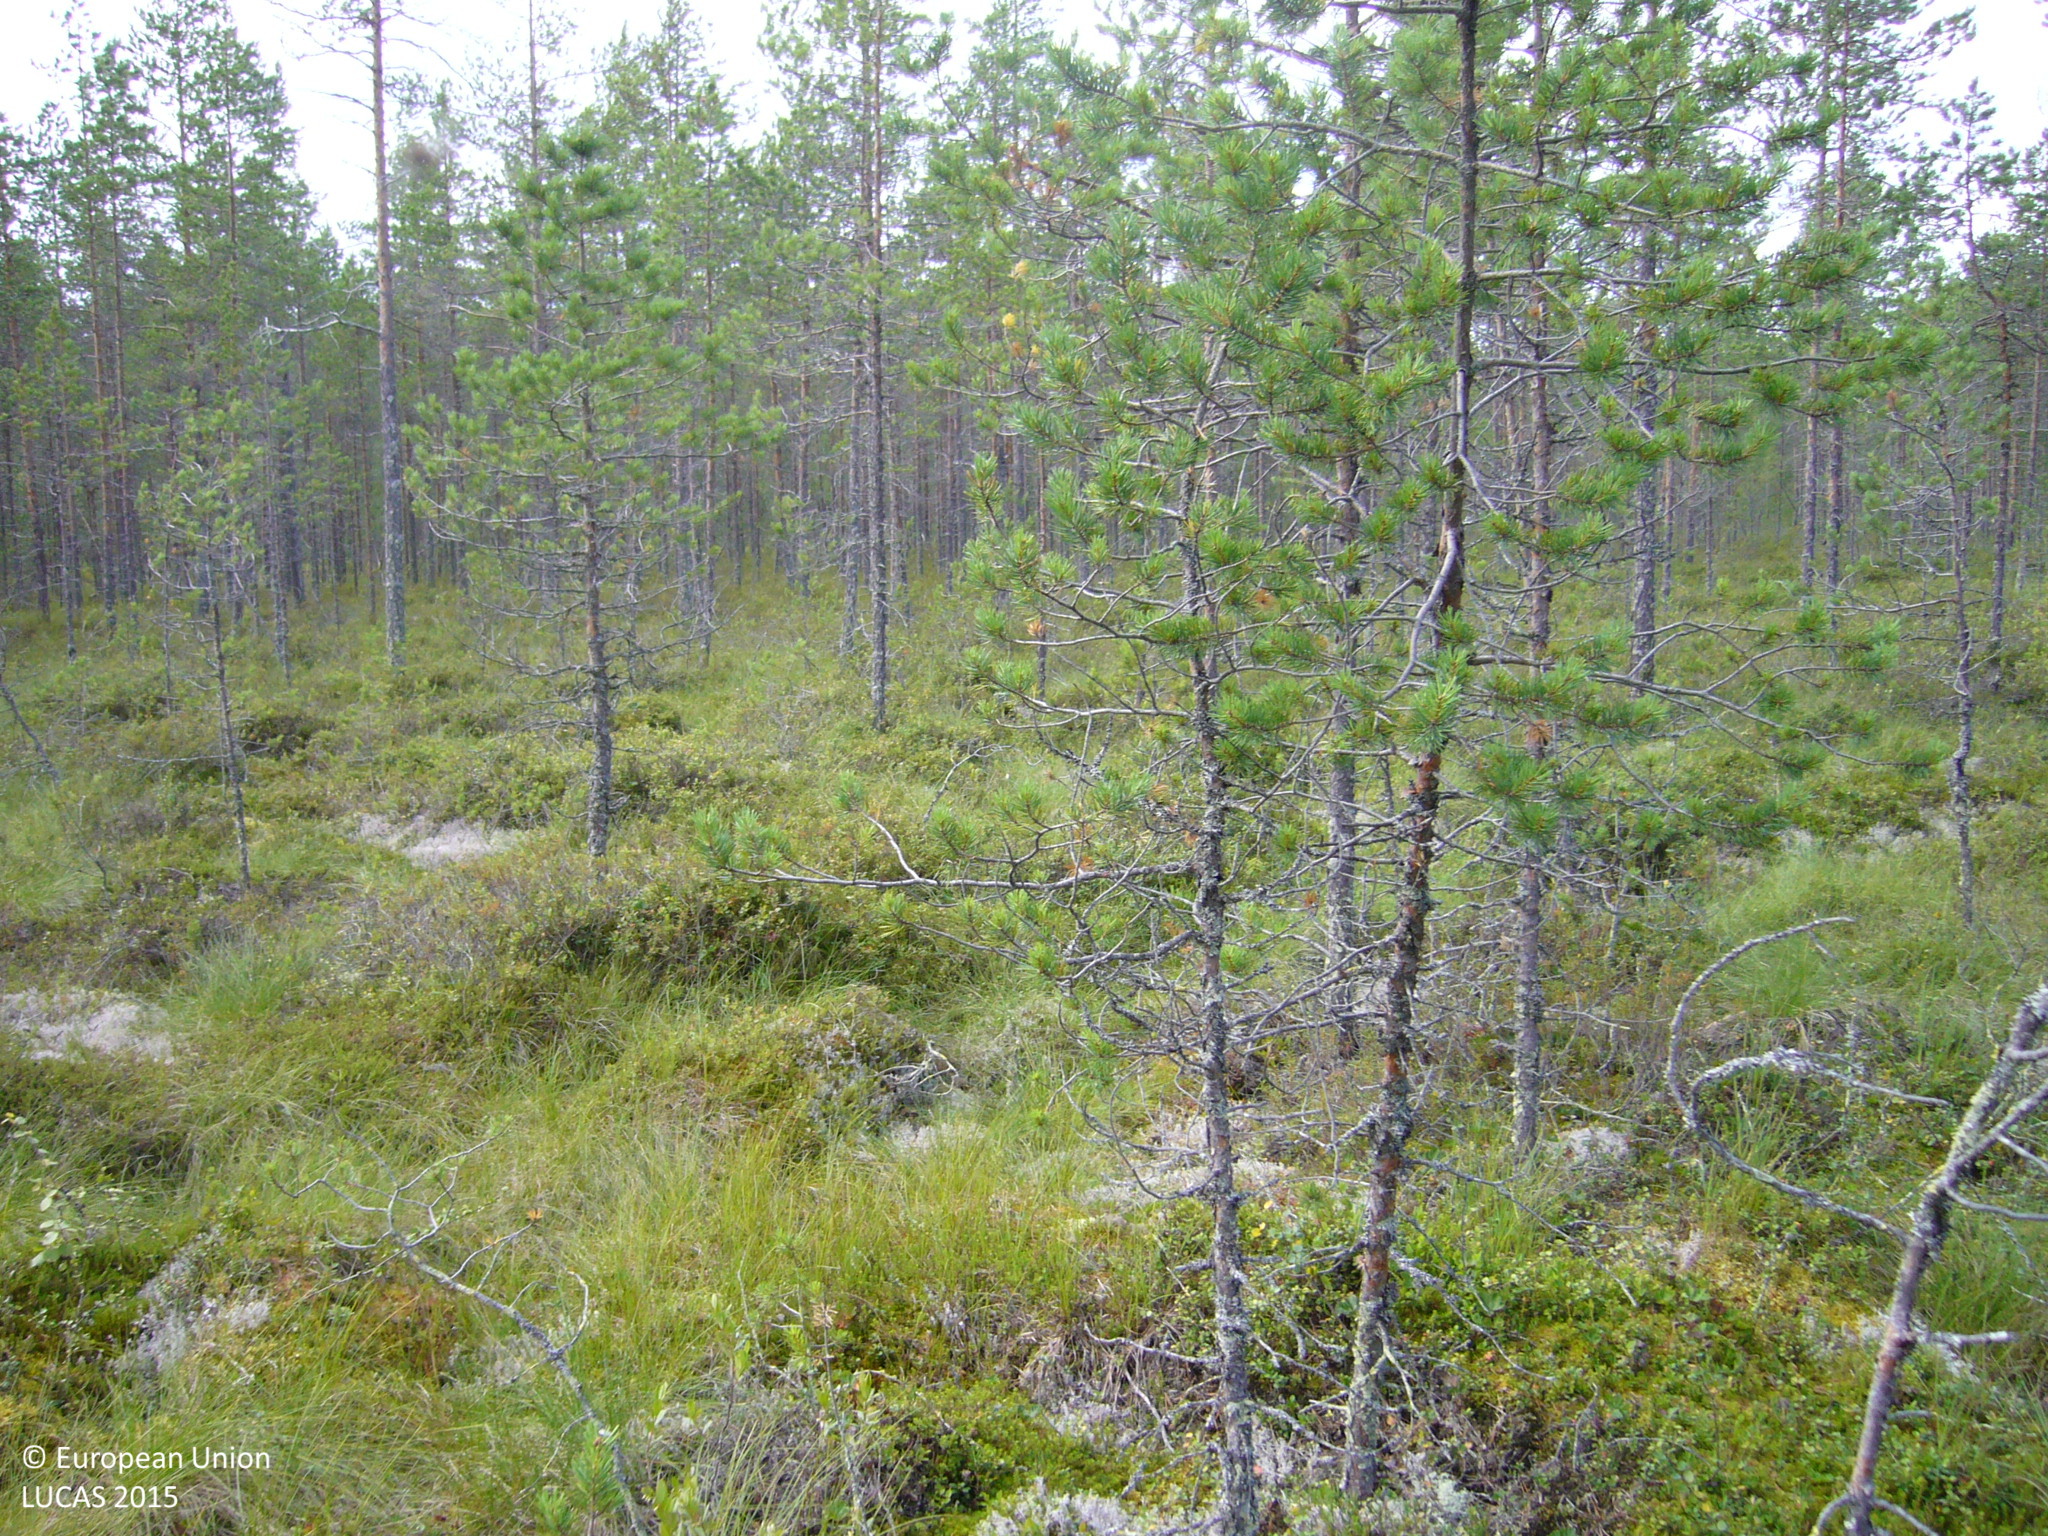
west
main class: Woodland
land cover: Pine dominated coniferous woodland
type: boreal forest
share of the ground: 50 - 75 %
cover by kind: coniferous forest trees 50 %, lichens and mosses 30 %, shrubs 20 %
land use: Forestry
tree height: > 5 m
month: July
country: FI
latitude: 64.1011
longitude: 26.1361
